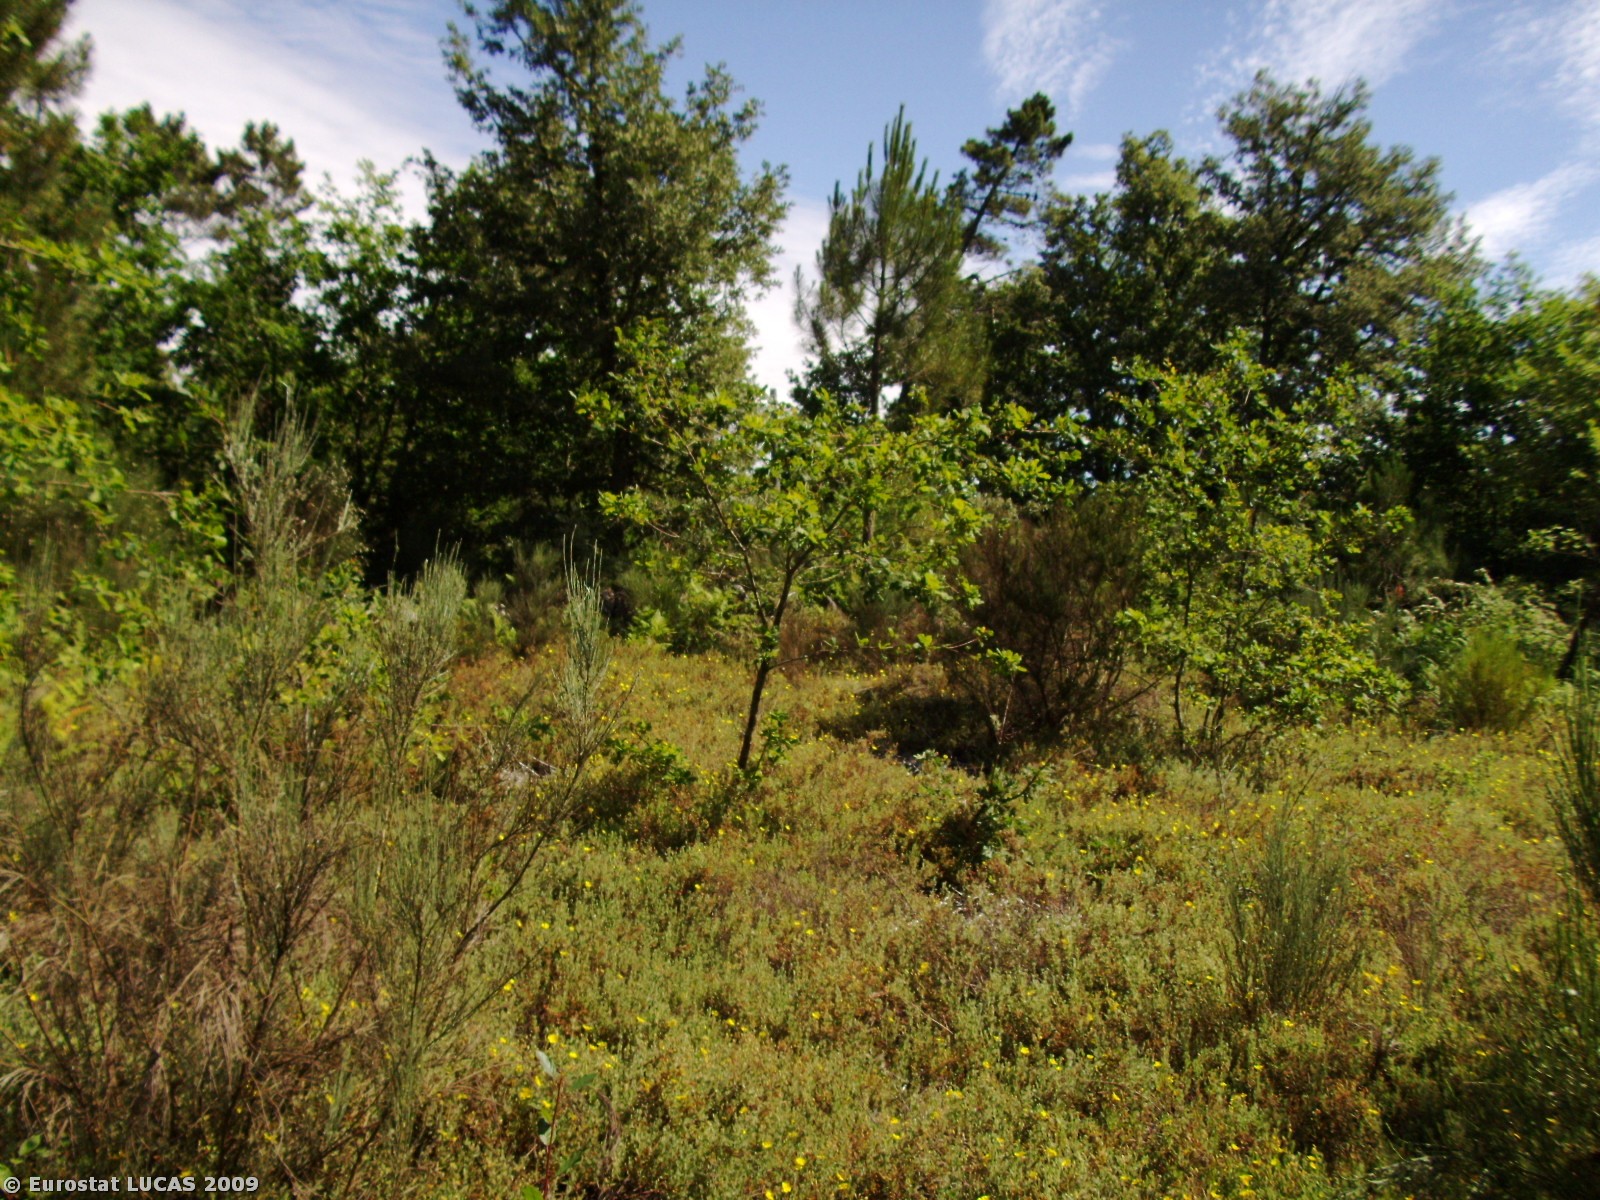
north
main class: Woodland
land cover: Broadleaved woodland
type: mesophytic deciduous forest
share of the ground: > 75 %
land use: Forestry
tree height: > 5 m
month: July
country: PT
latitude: 40.8430
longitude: -7.6868
